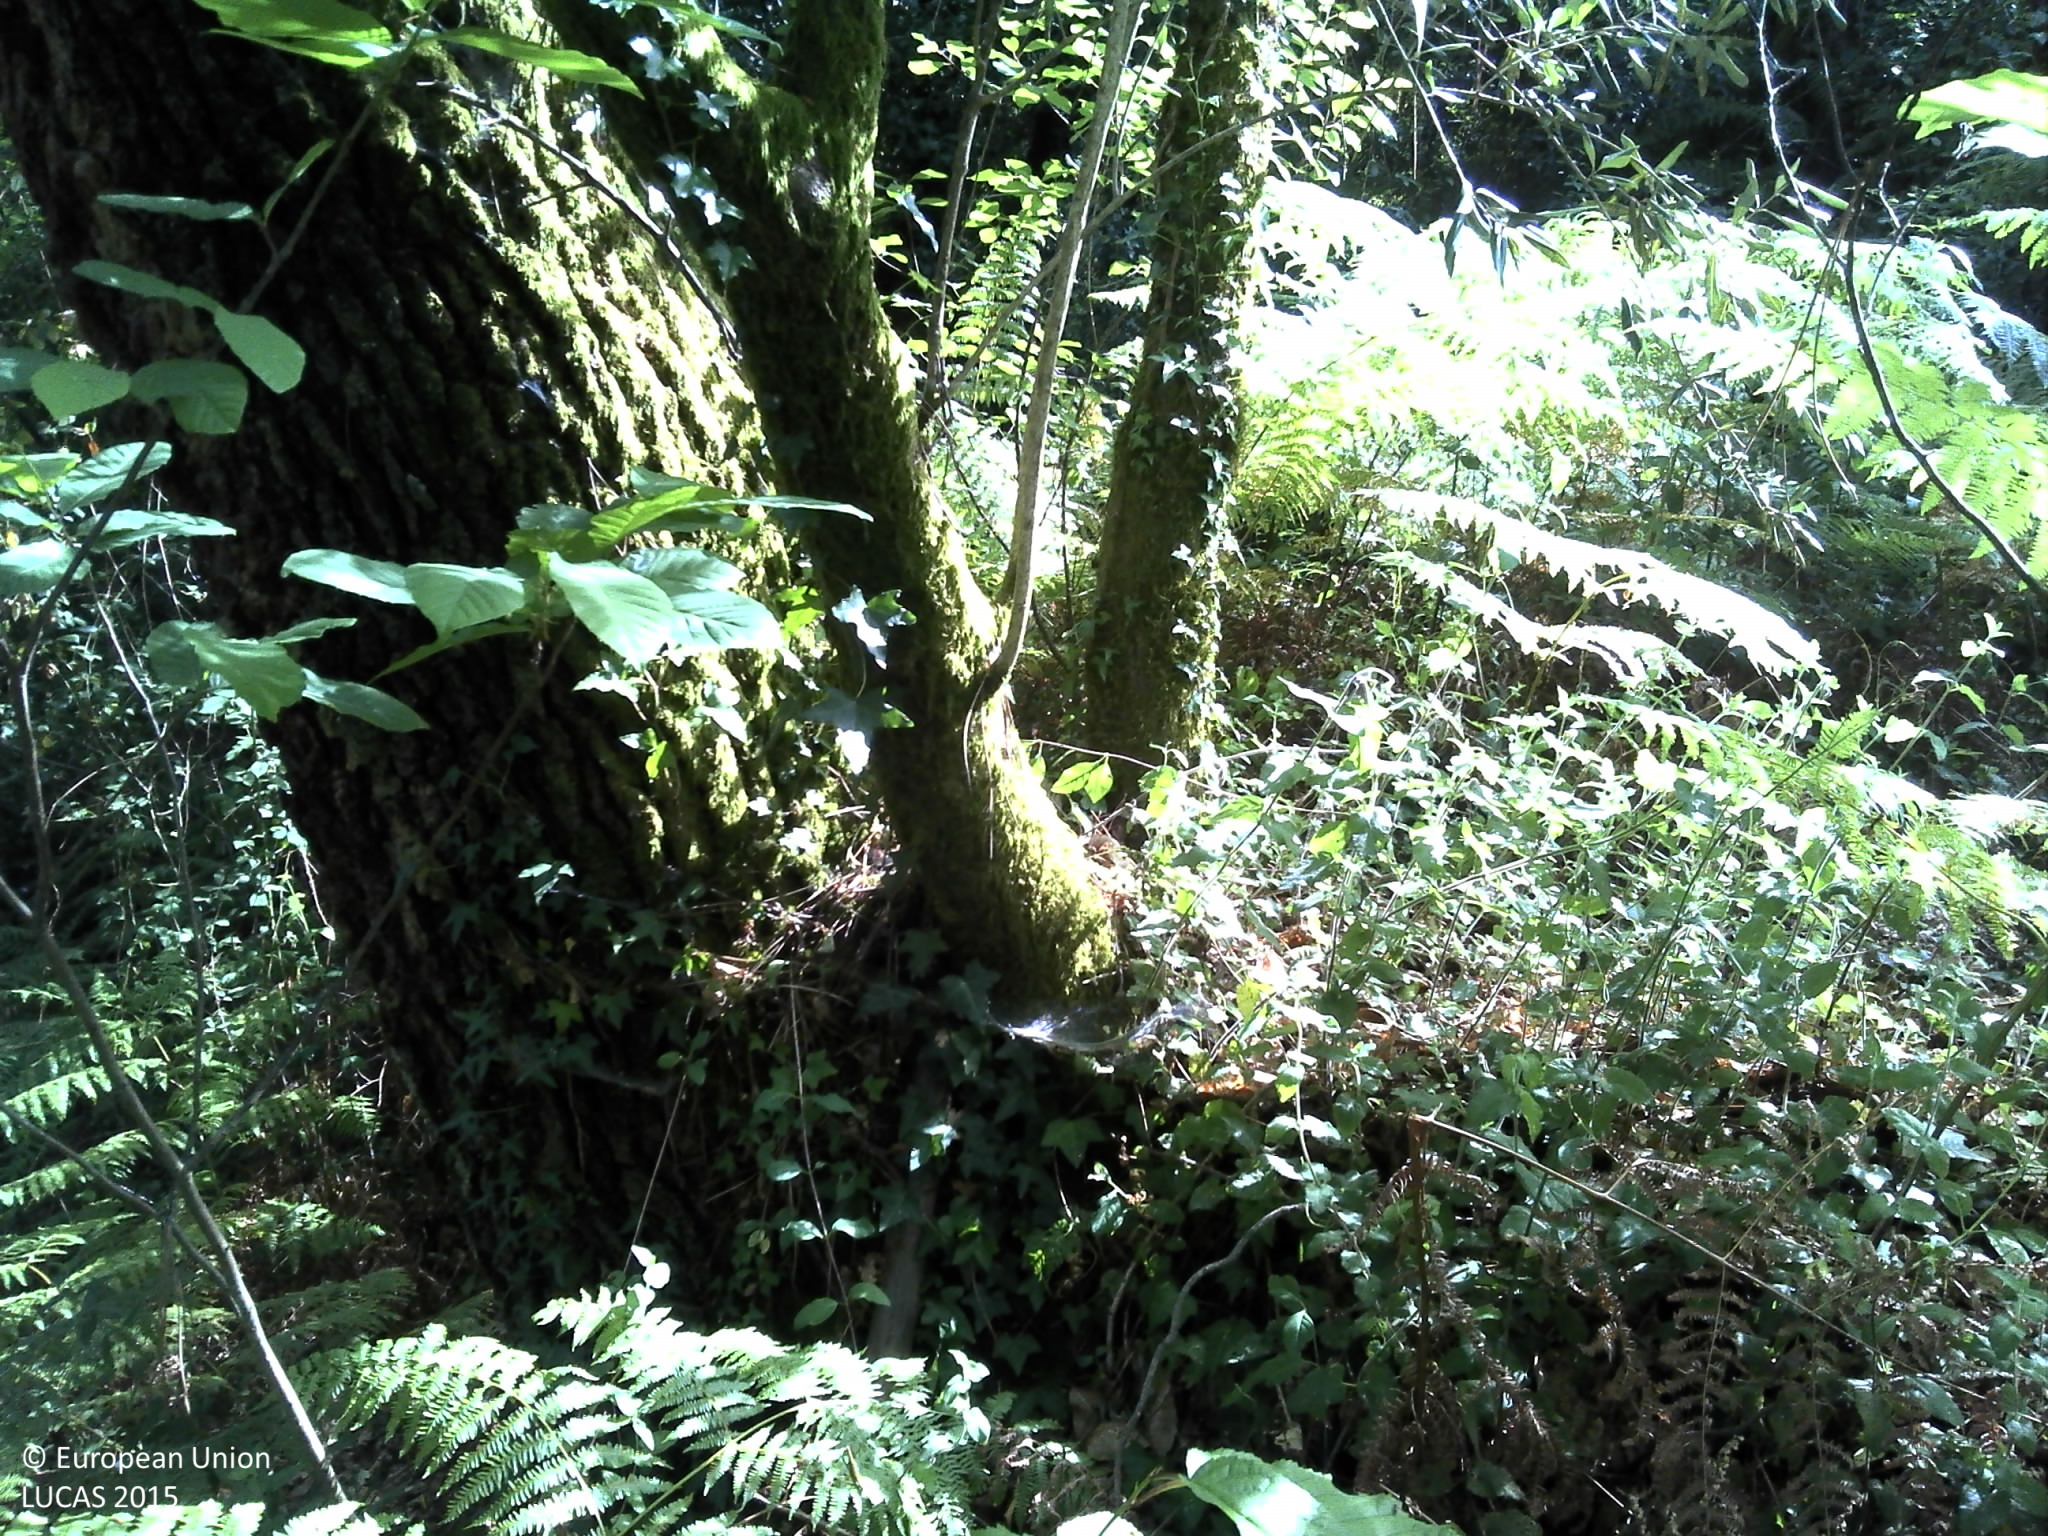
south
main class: Woodland
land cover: Pine dominated mixed woodland
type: coniferous forest of the mediterranean region
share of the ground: > 75 %
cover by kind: broadleaved forest trees 75 %, coniferous forest trees 25 %
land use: Forestry
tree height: > 5 m
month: June
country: PT
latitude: 41.7939
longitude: -8.4379
